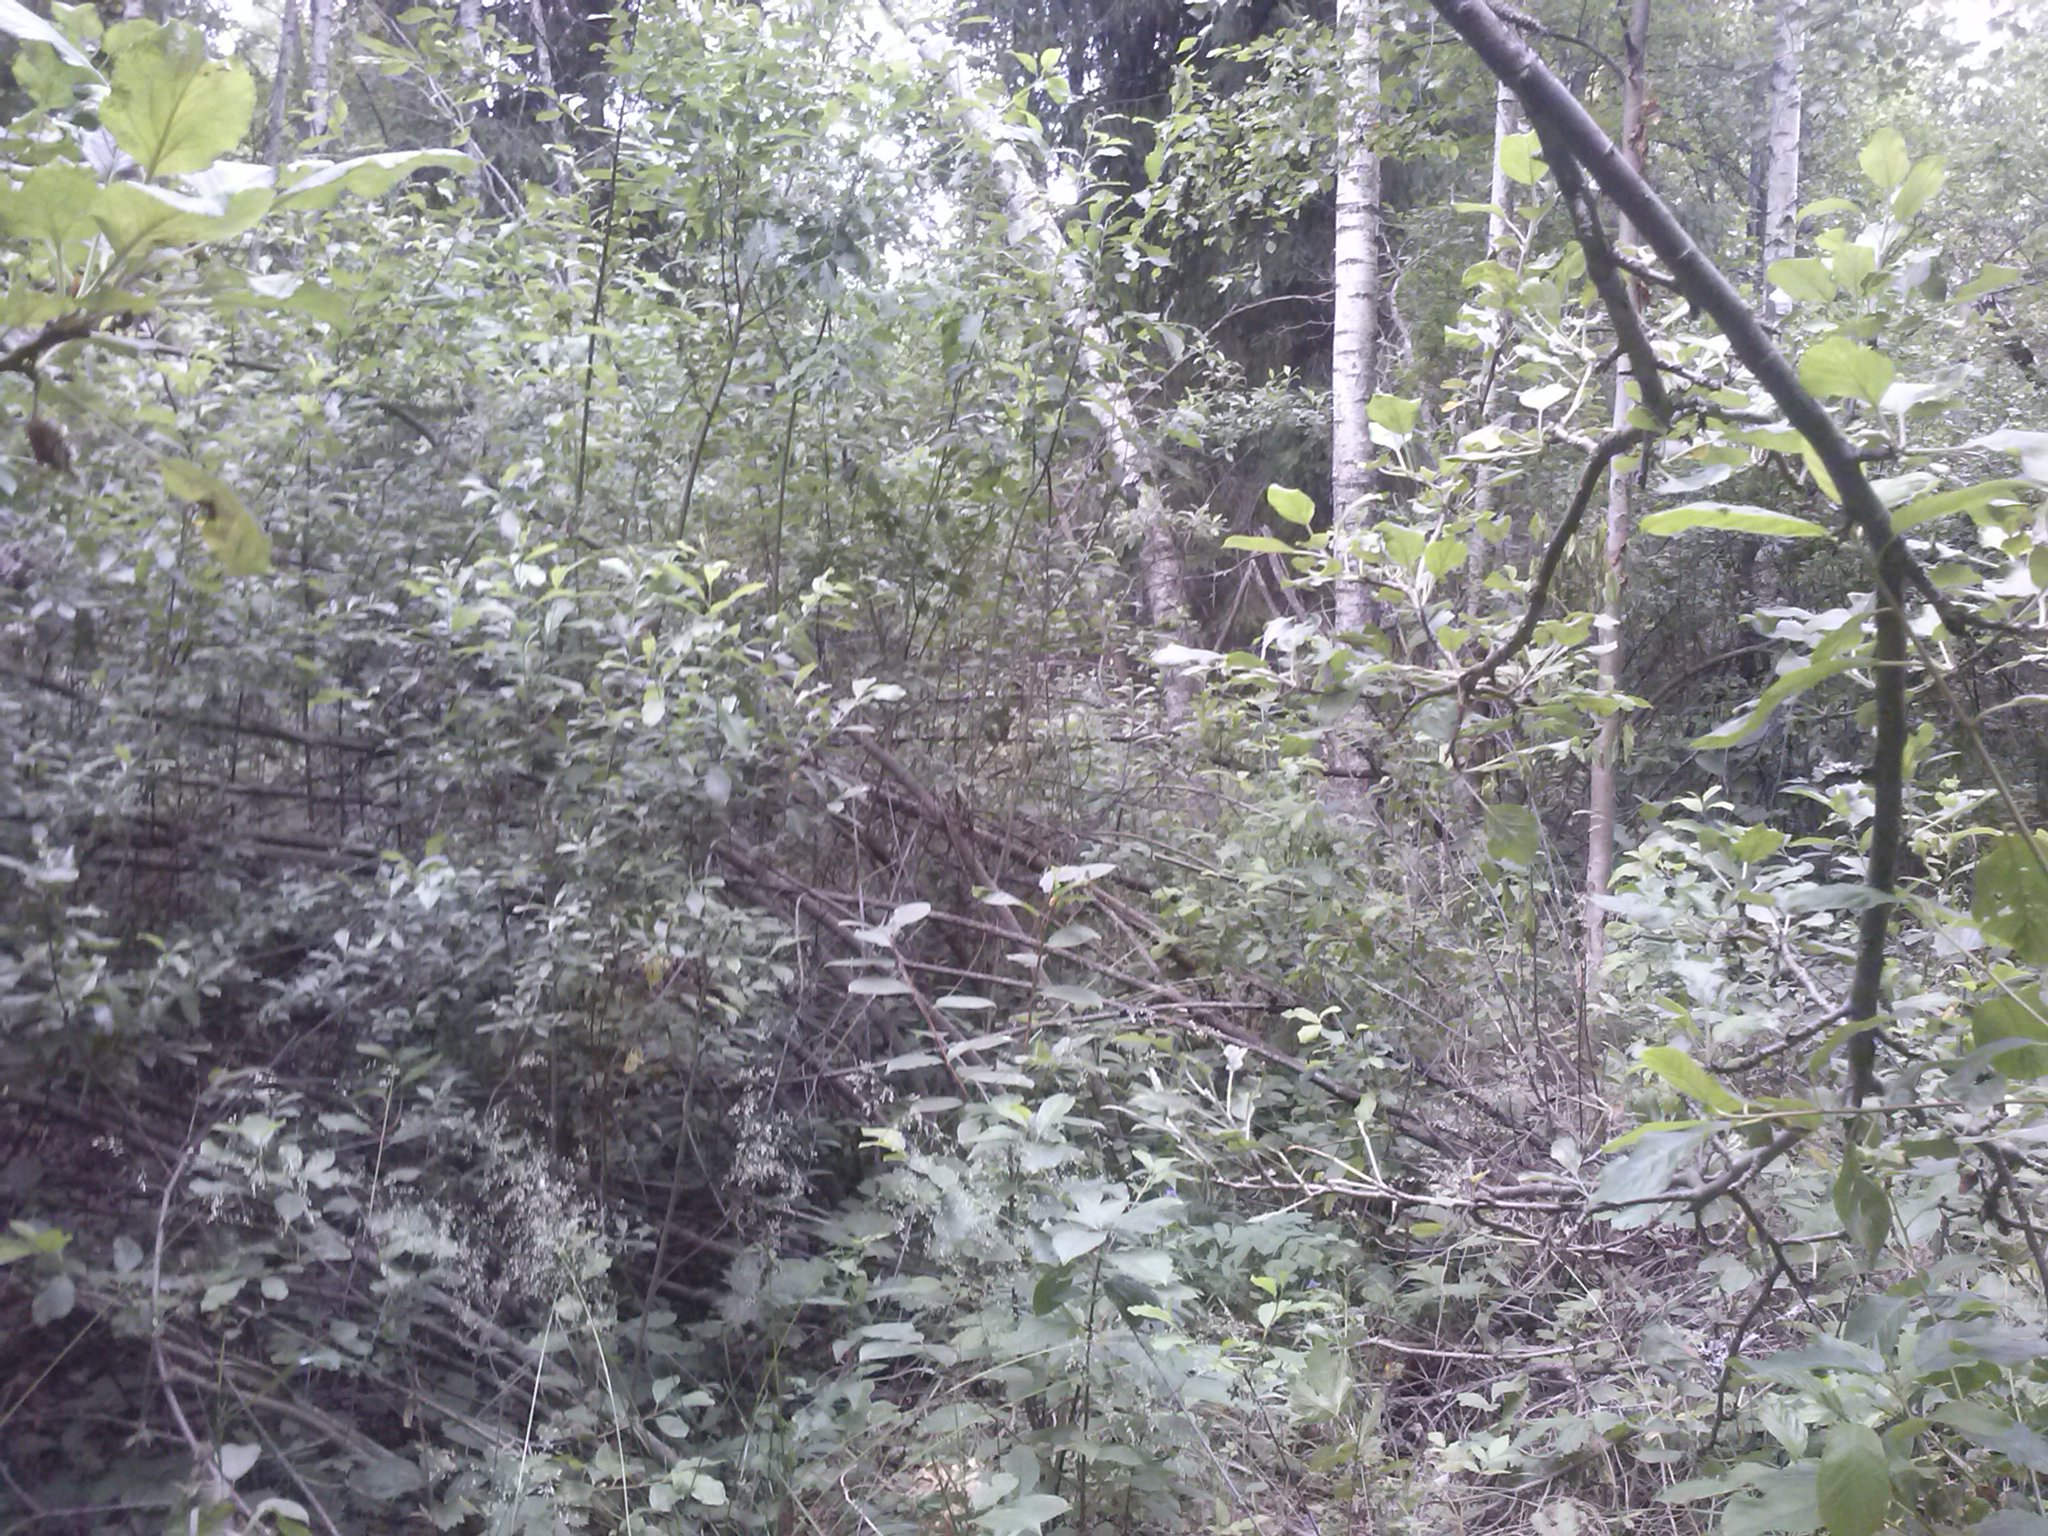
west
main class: Woodland
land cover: Broadleaved woodland
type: non-riverine alder, birch or aspen forest
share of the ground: > 75 %
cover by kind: broadleaved forest trees 80 %, shrubs 10 %, coniferous forest trees 5 %, herbaceous plants 5 %
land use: Forestry
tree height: > 5 m
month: July
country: LV
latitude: 56.8304
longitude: 27.3982
